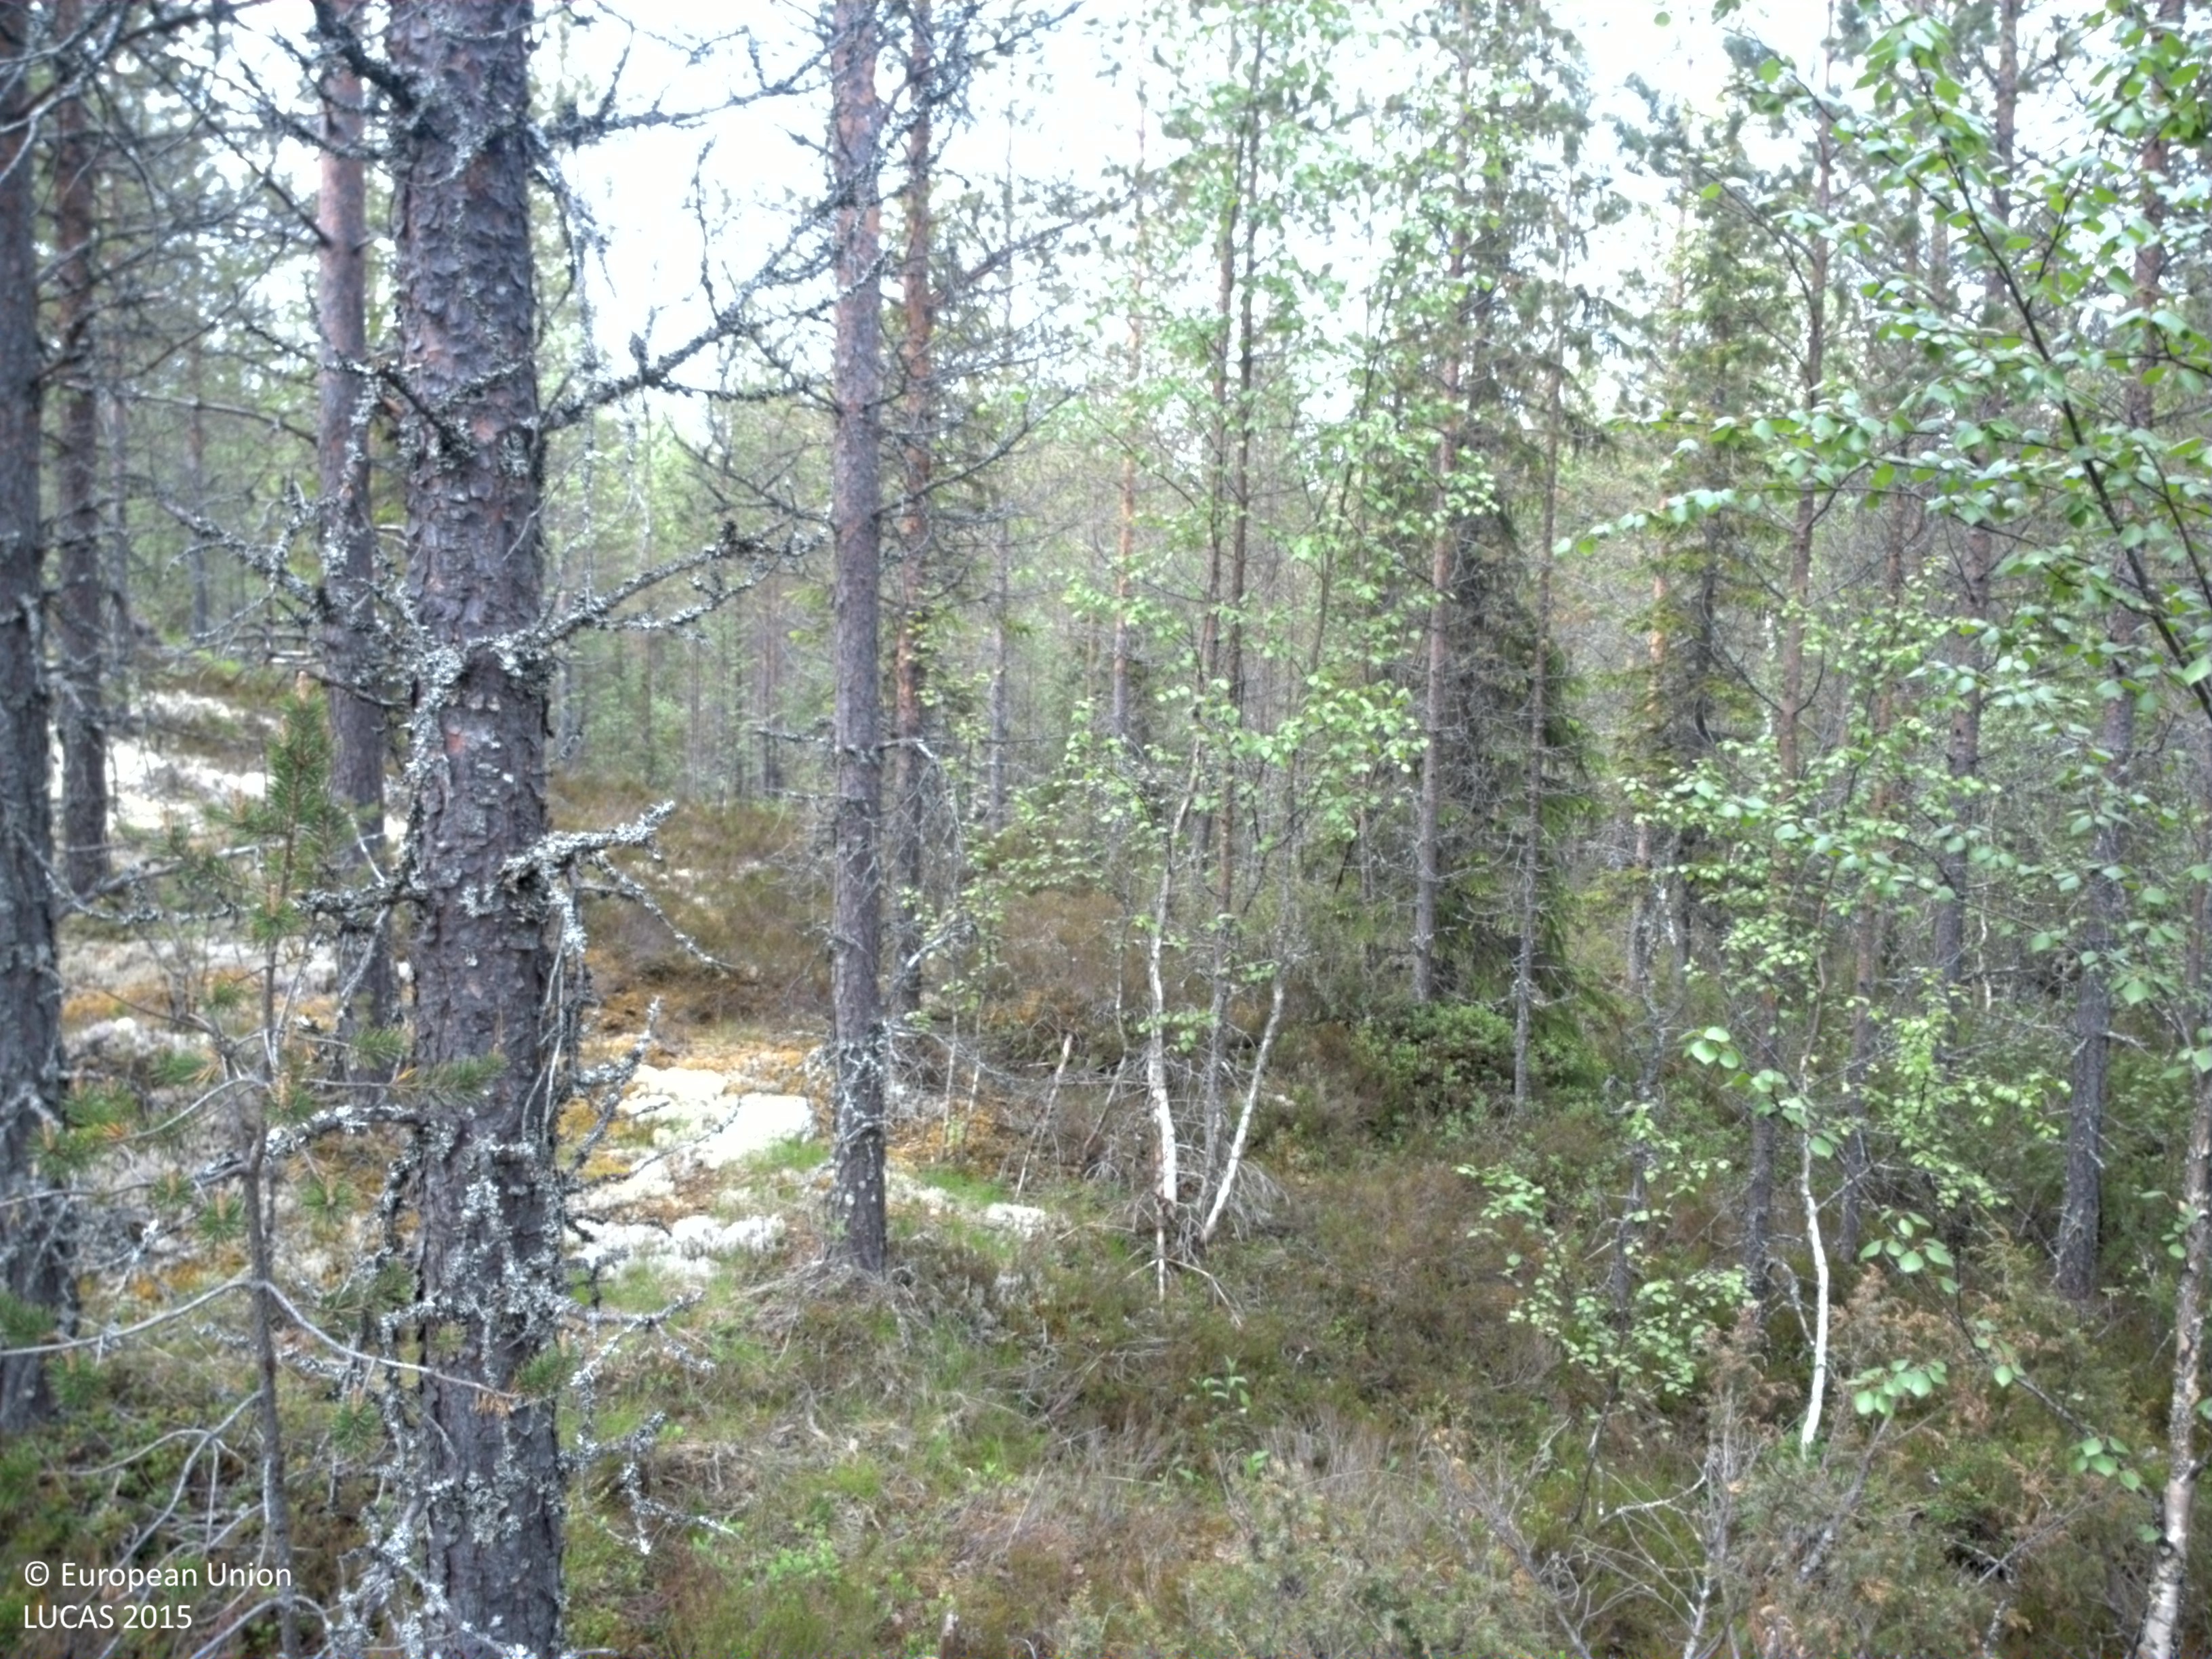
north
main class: Woodland
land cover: Pine dominated coniferous woodland
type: boreal forest
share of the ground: 25 - 50 %
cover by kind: coniferous forest trees 40 %, lichens and mosses 35 %, herbaceous plants 25 %
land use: Forestry
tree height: > 5 m
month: June
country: SE
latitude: 61.3795
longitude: 13.5619
